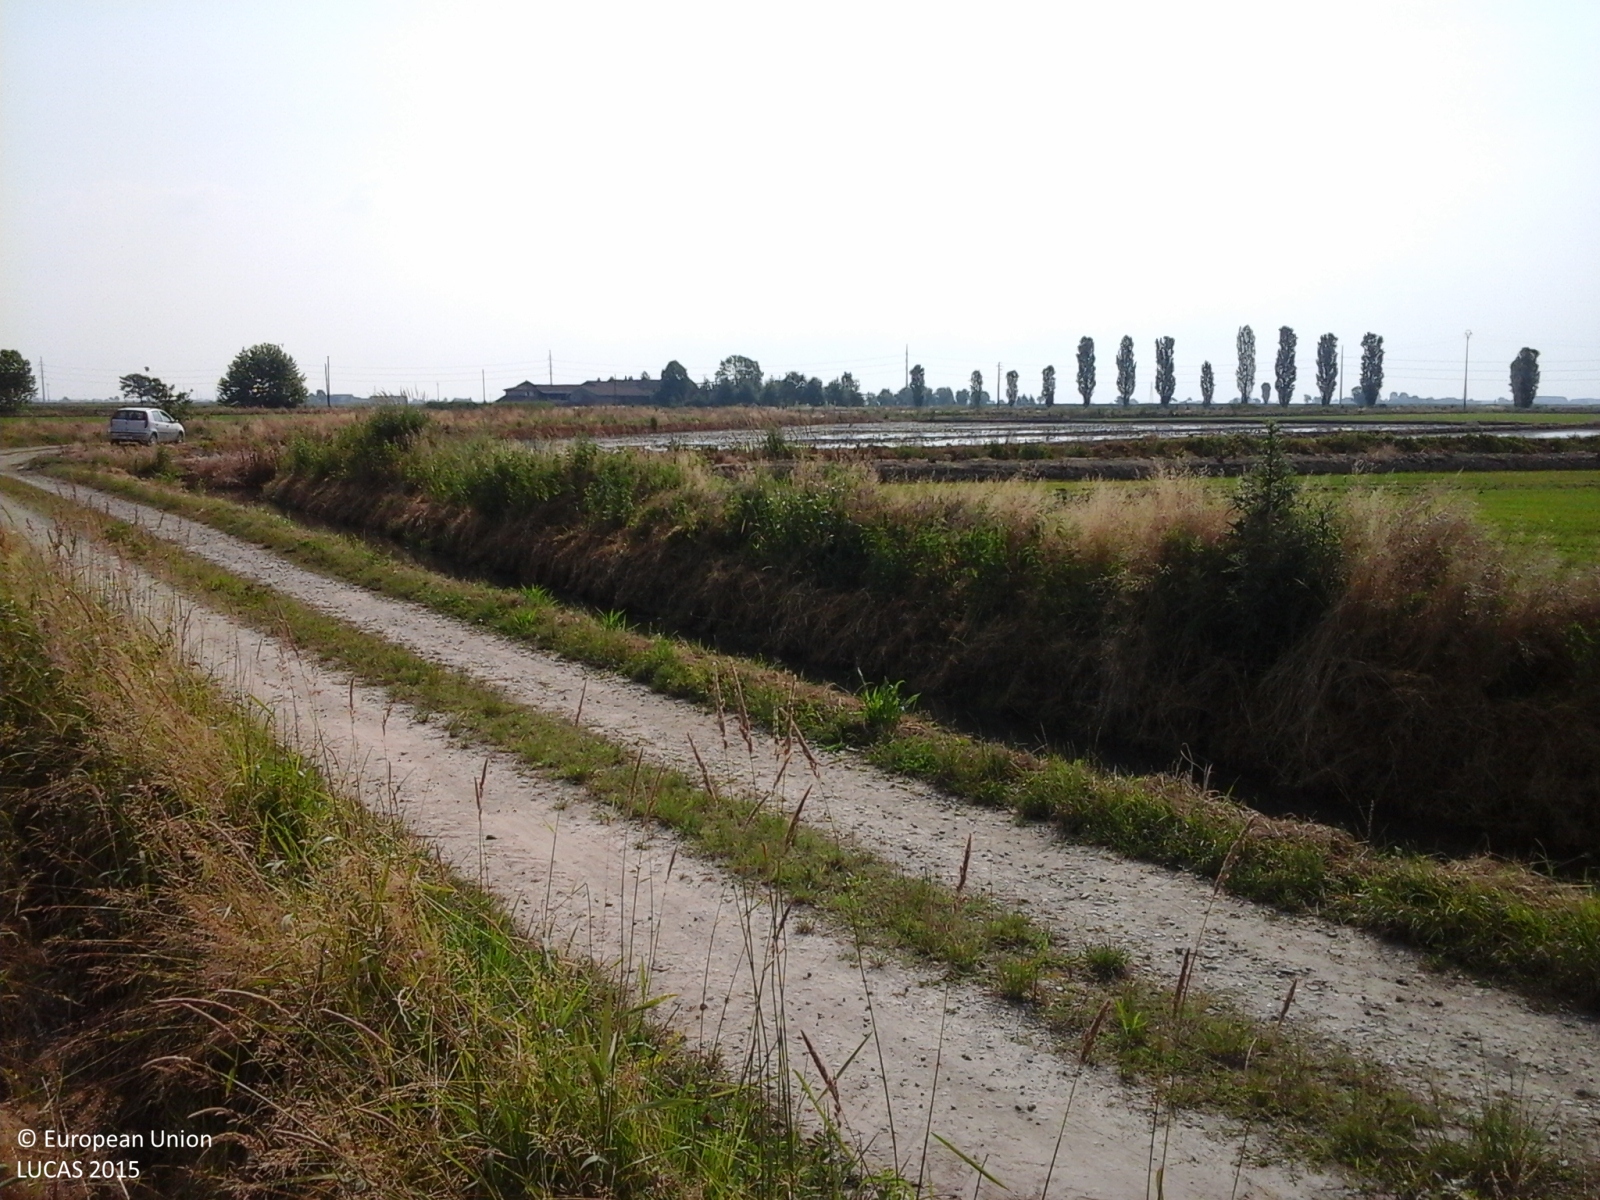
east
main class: Cropland
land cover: Rice
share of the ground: 25 - 50 %
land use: Agriculture (excluding fallow land and kitchen gardens)
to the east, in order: Grass margins; Ditches and canals; Grass margins; Tracks; Grass margins; Ditches and canals; Grass margins; Rice; Grass margins; Ditches and canals; Grass margins; Rice; Other structural elements; Rice; Grass margins; Ditches and canals; Grass margins; Tracks; Grass margins; Ditches and canals; Grass margins; Rice
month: May
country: IT
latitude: 45.2561
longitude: 8.2827
